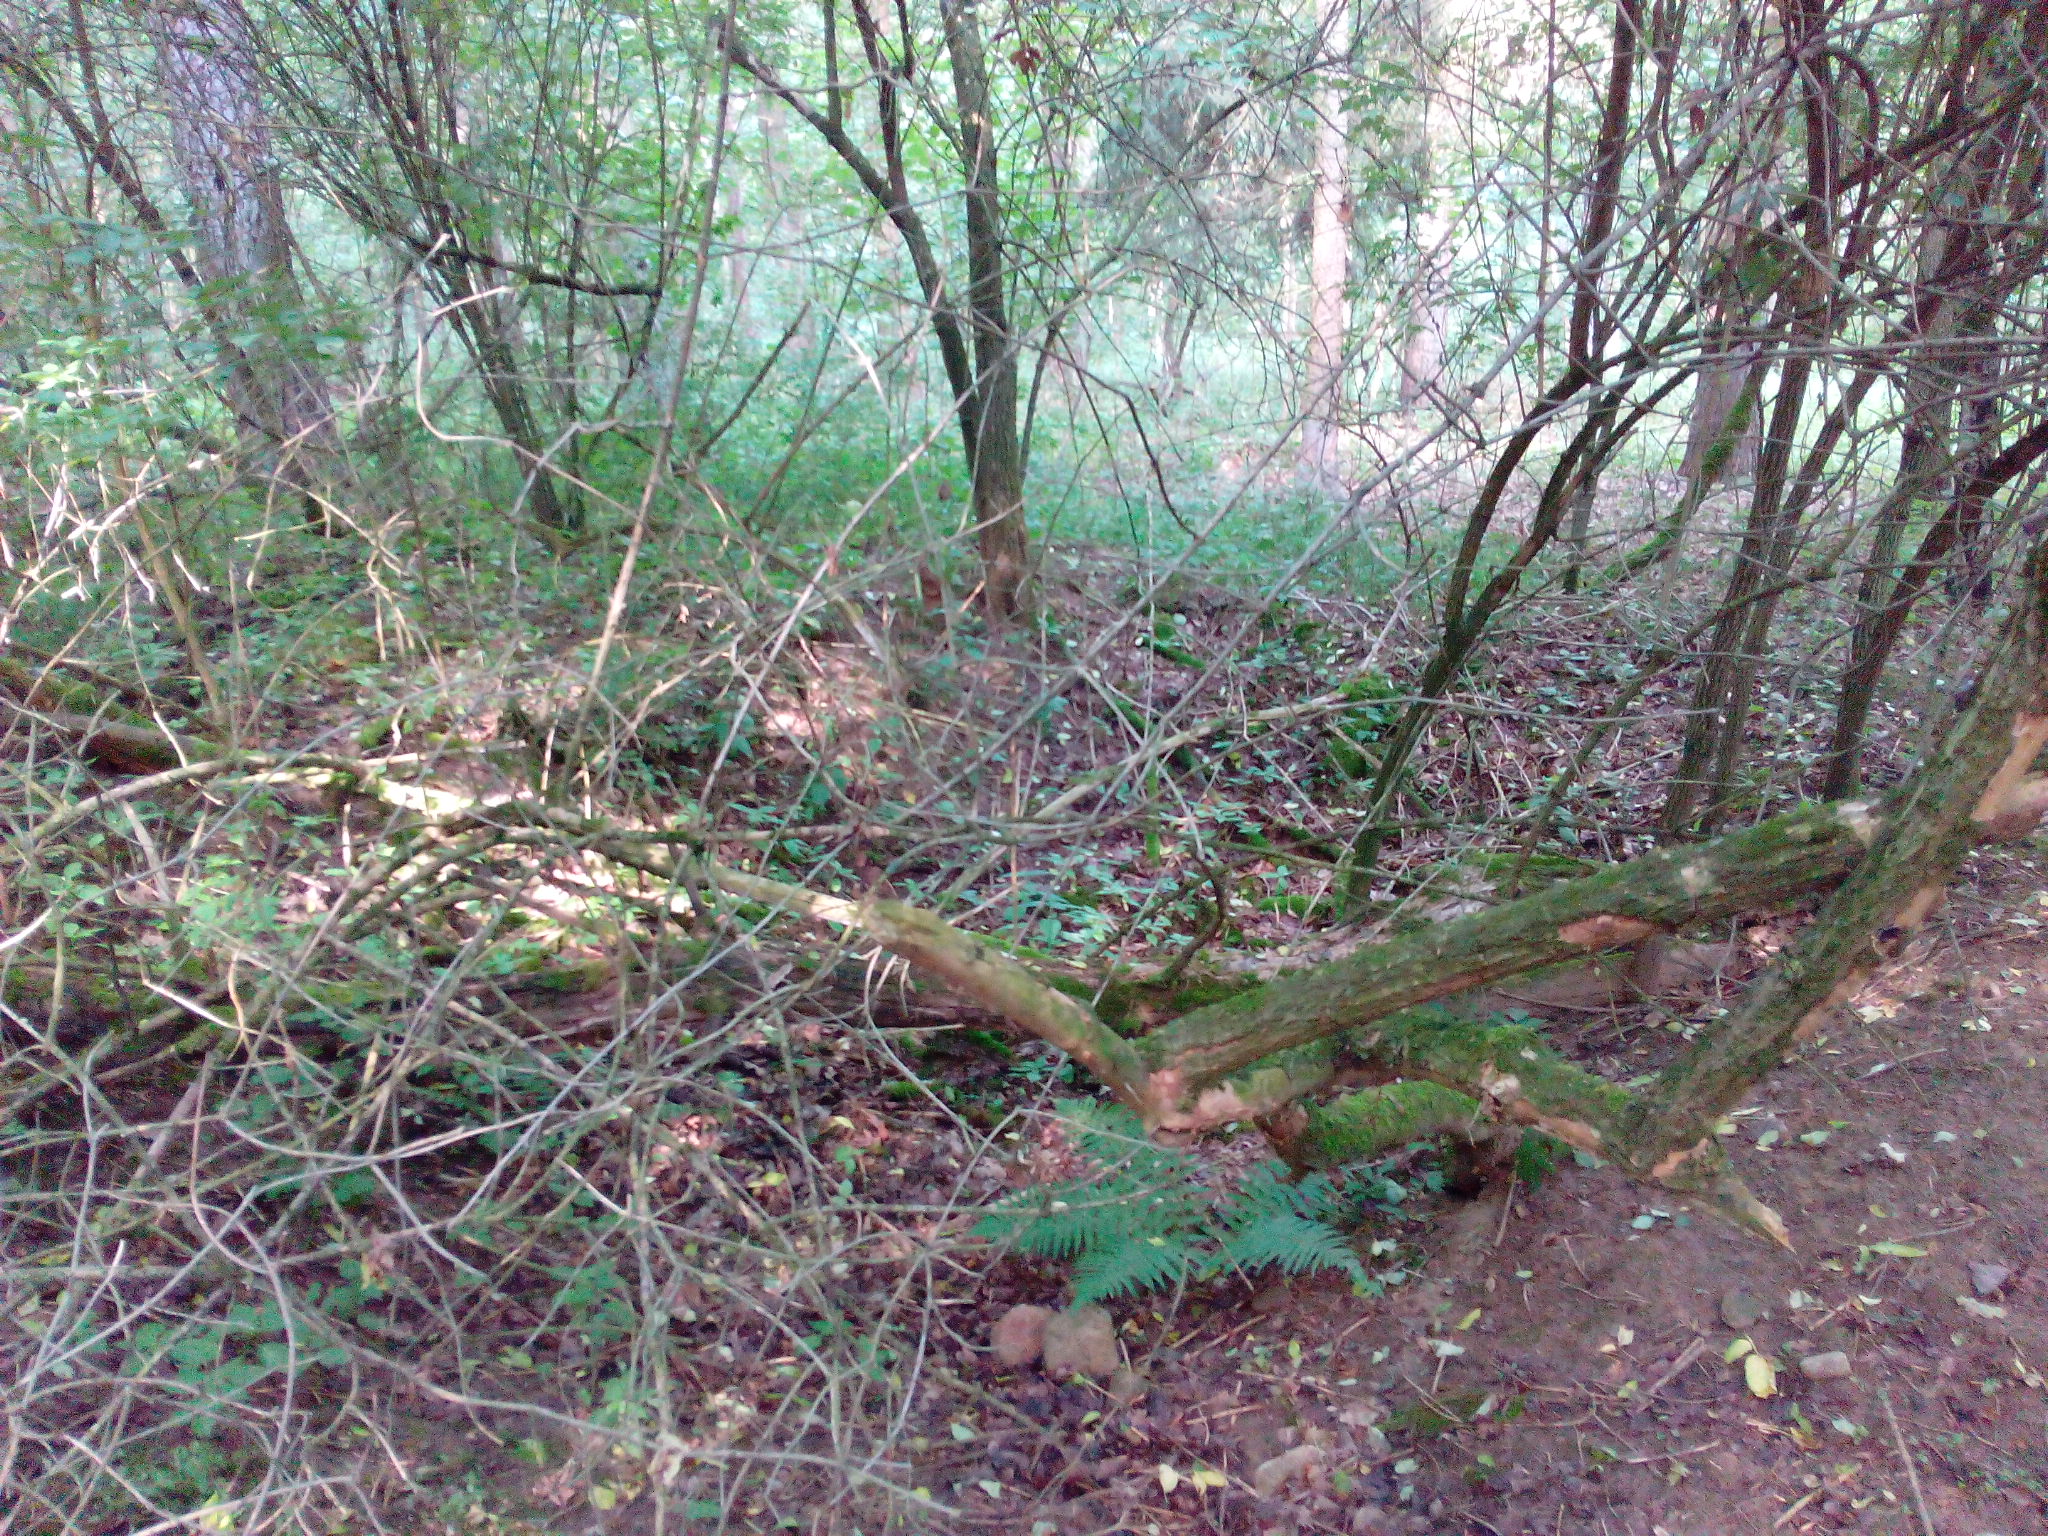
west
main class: Woodland
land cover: Other mixed woodland
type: hemiboreal forest and nemoral coniferous forest and mixed broadleaved-coniferous forest
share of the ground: > 75 %
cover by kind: broadleaved forest trees 50 %, coniferous forest trees 40 %, shrubs 5 %, herbaceous plants 5 %
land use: Forestry
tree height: > 5 m
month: July
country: DE
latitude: 53.1860
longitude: 14.1760
